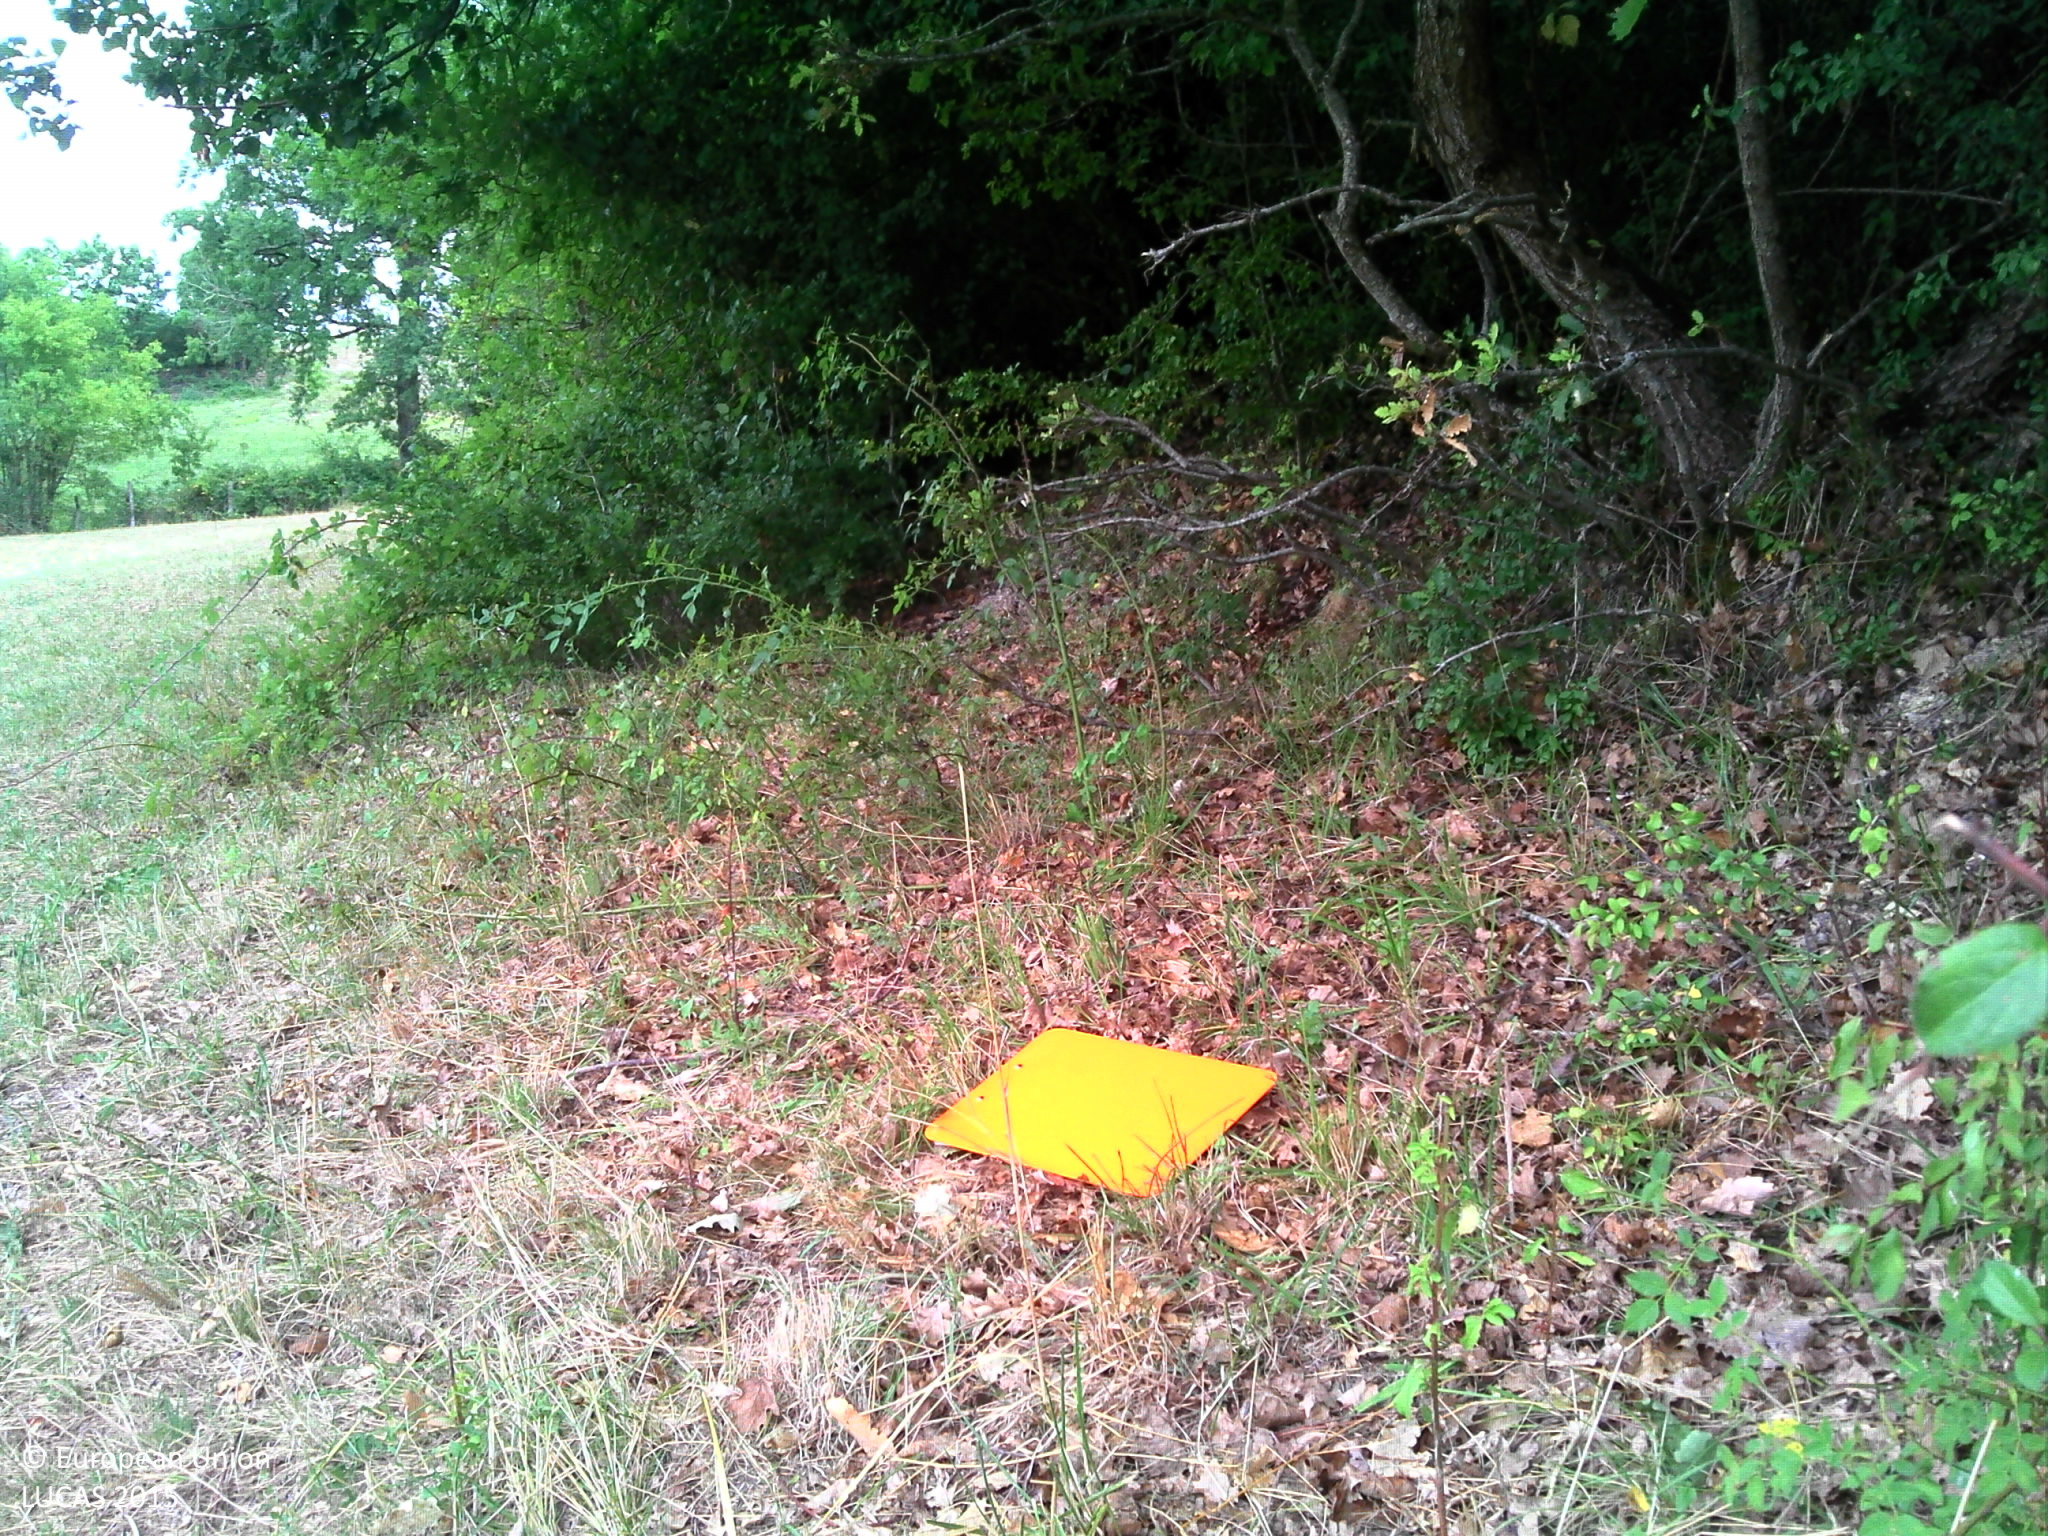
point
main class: Woodland
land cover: Broadleaved woodland
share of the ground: > 75 %
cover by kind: broadleaved forest trees 80 %, shrubs 20 %
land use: Agriculture (excluding fallow land and kitchen gardens)
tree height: > 5 m
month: July
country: FR
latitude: 44.6688
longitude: 0.8235
